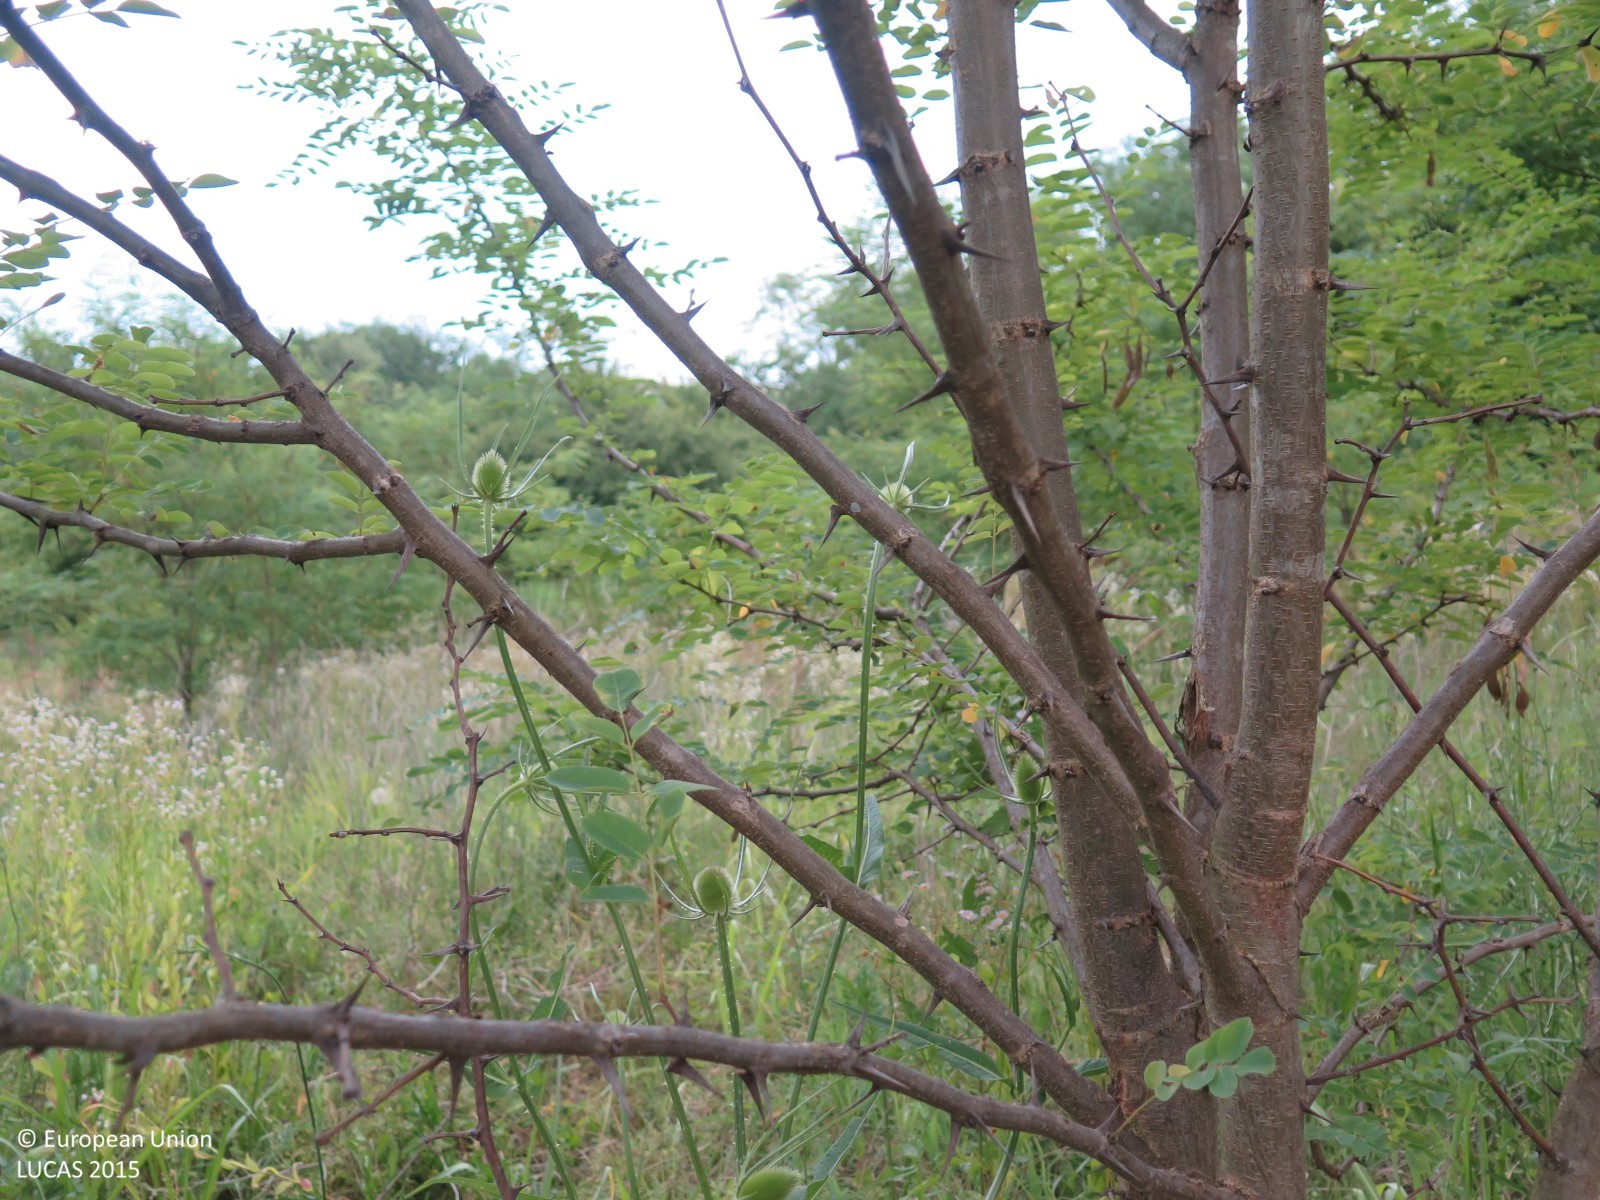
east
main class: Grassland
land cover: Grassland with sparse tree/shrub cover
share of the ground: > 75 %
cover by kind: herbaceous plants 90 %, broadleaved forest trees 5 %, shrubs 5 %
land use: Semi-natural and natural areas not in use
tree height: > 5 m
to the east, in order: Grassland with sparse tree/shrub cover; Grass margins; Tracks; Grass margins; Abandoned hedges; Shrubland with sparse tree cover; Broadleaved woodland; Tracks; Grass margins; Sand; Artificial constructions in urban areas; Broadleaved woodland; Other fresh vegetables
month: July
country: HR
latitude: 45.3274
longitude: 13.8099
